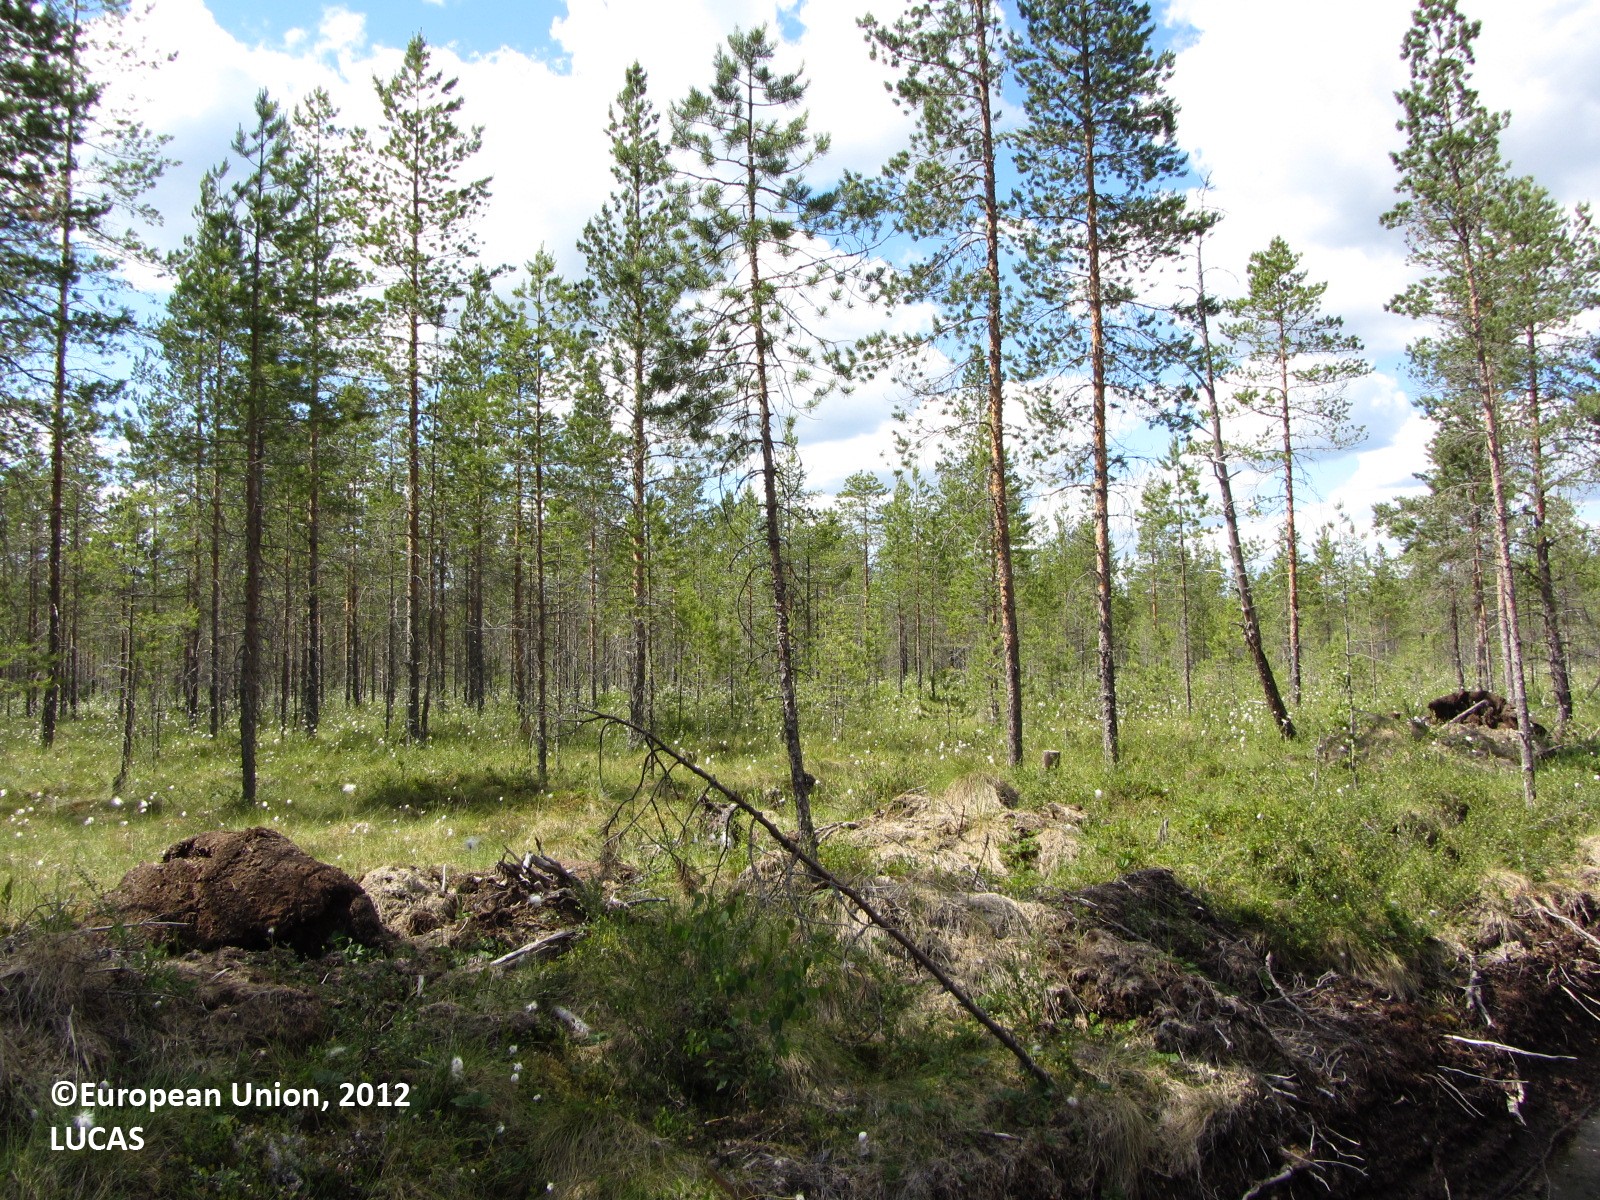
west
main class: Woodland
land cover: Pine dominated coniferous woodland
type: boreal forest
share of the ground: 50 - 75 %
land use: Forestry
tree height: > 5 m
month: July
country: FI
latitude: 63.2582
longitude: 25.3388
